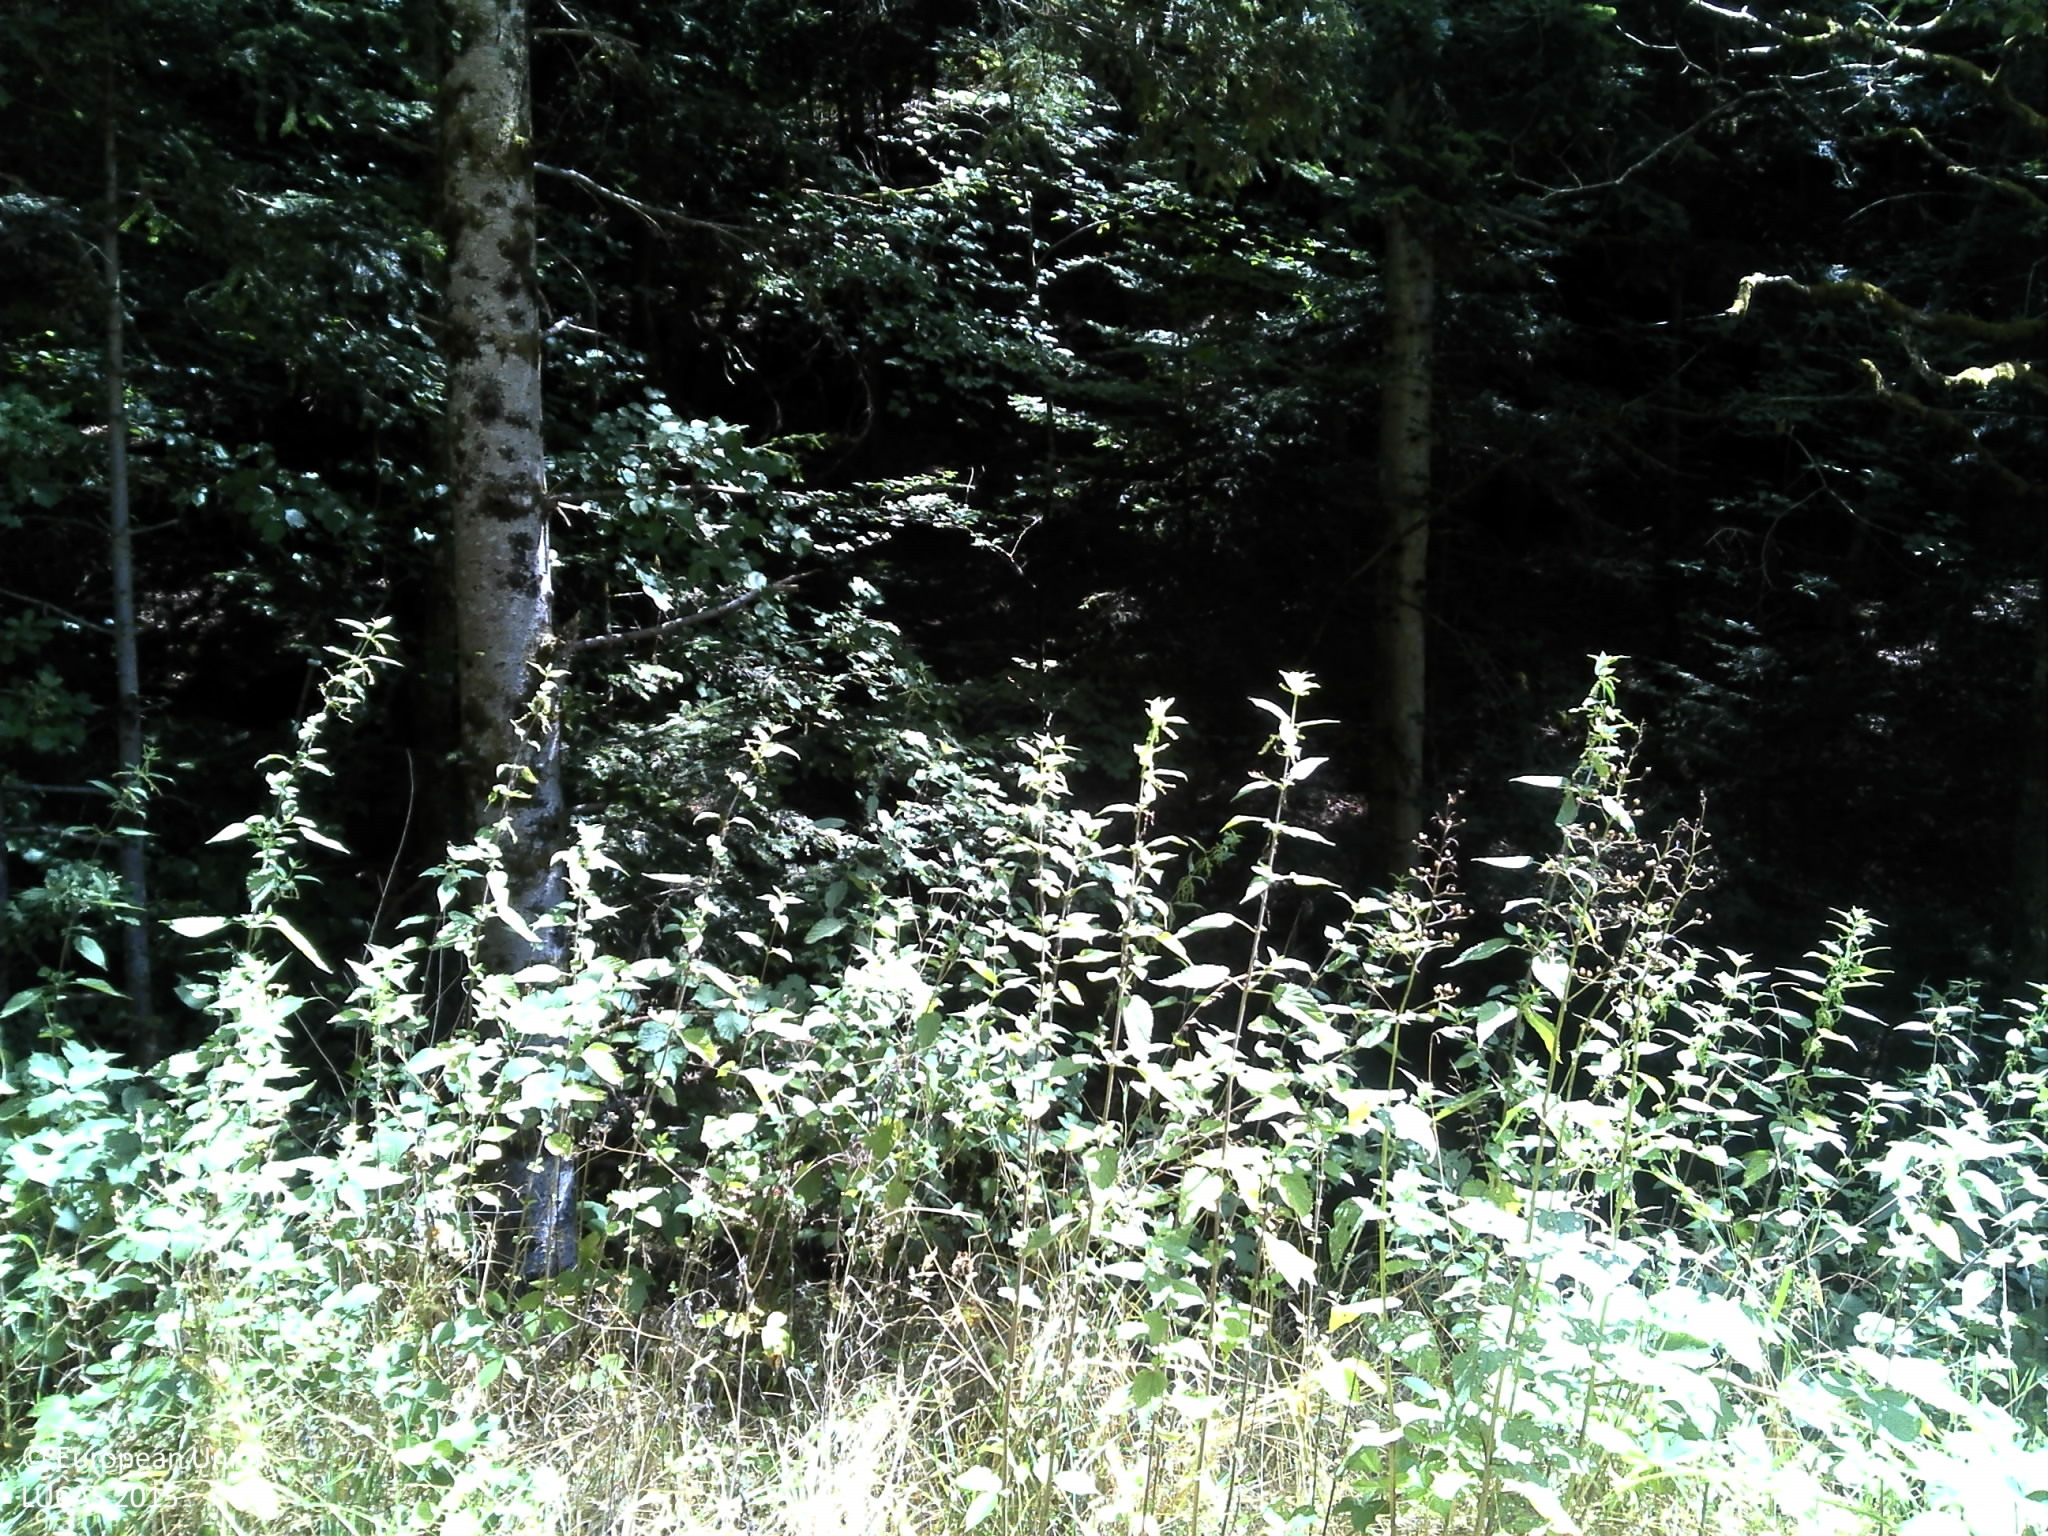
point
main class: Woodland
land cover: Spruce dominated mixed woodland
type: broadleaved evergreen forest
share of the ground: > 75 %
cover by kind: coniferous forest trees 40 %, broadleaved forest trees 20 %, herbaceous plants 20 %, shrubs 10 %, lichens and mosses 10 %
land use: Forestry
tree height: > 5 m
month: July
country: FR
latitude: 45.5528
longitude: 3.4301
